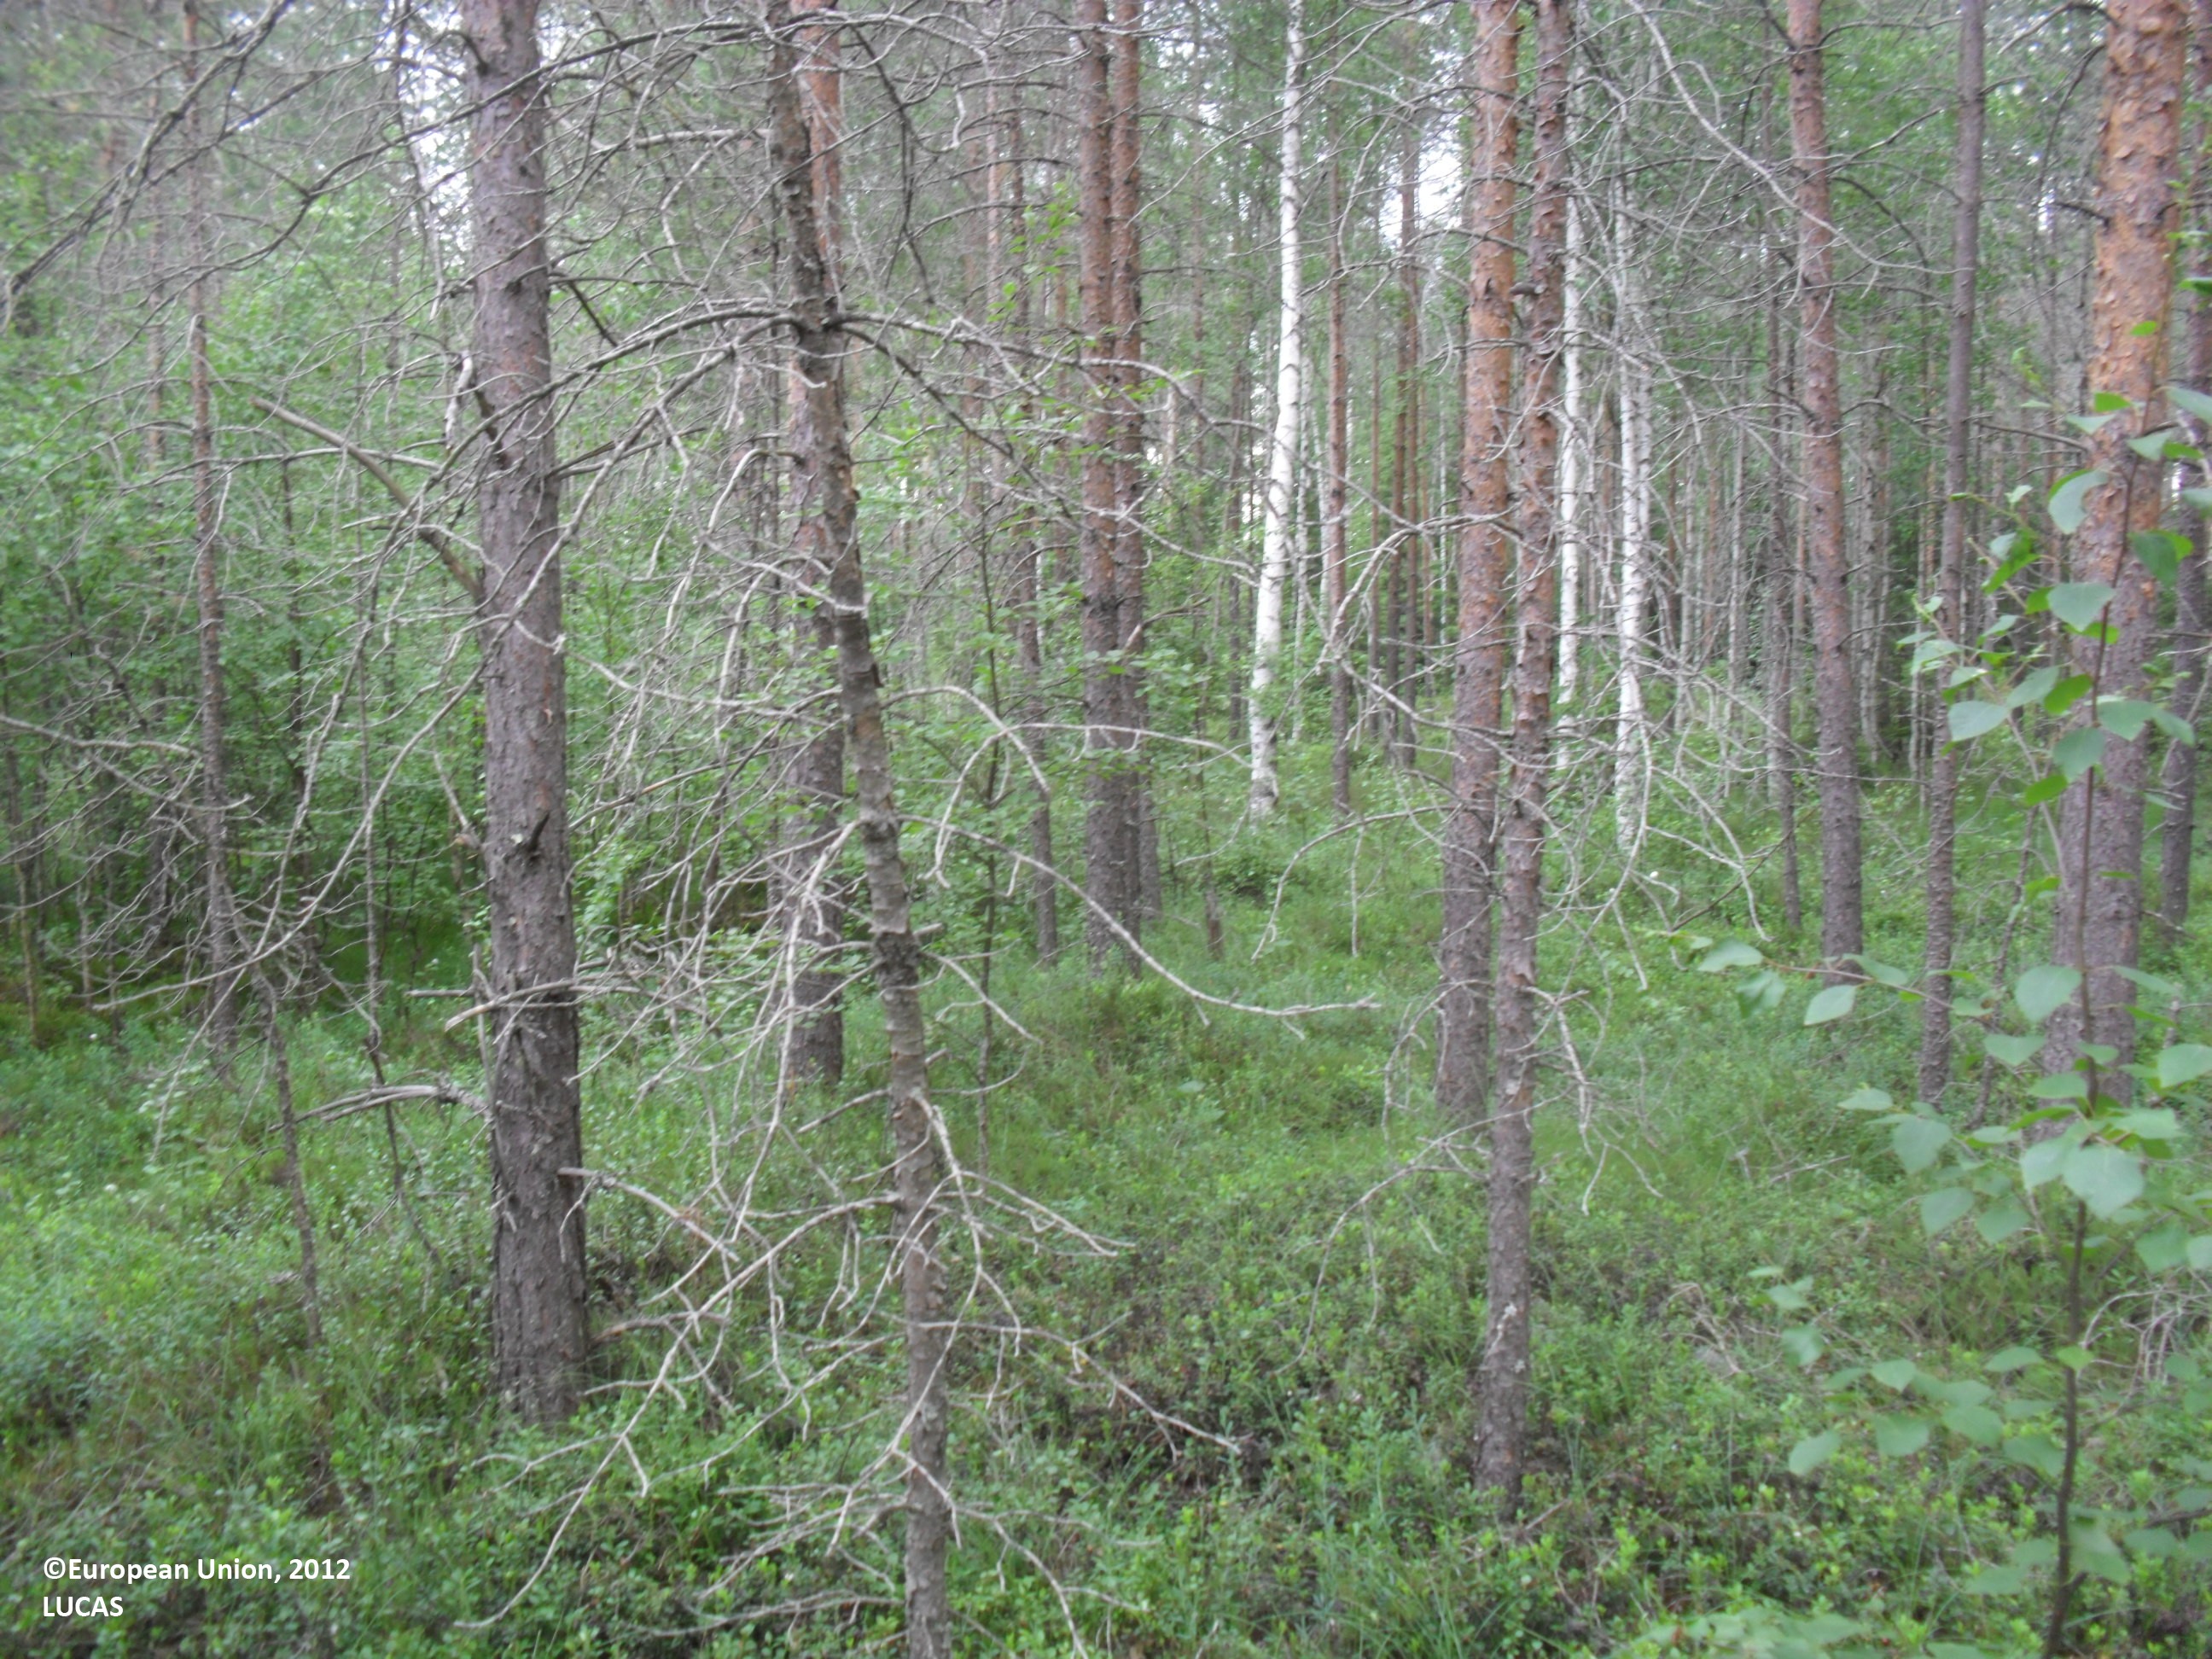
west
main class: Woodland
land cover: Pine dominated coniferous woodland
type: boreal forest
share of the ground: 50 - 75 %
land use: Forestry
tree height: > 5 m
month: July
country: FI
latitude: 63.6008
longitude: 23.6710
